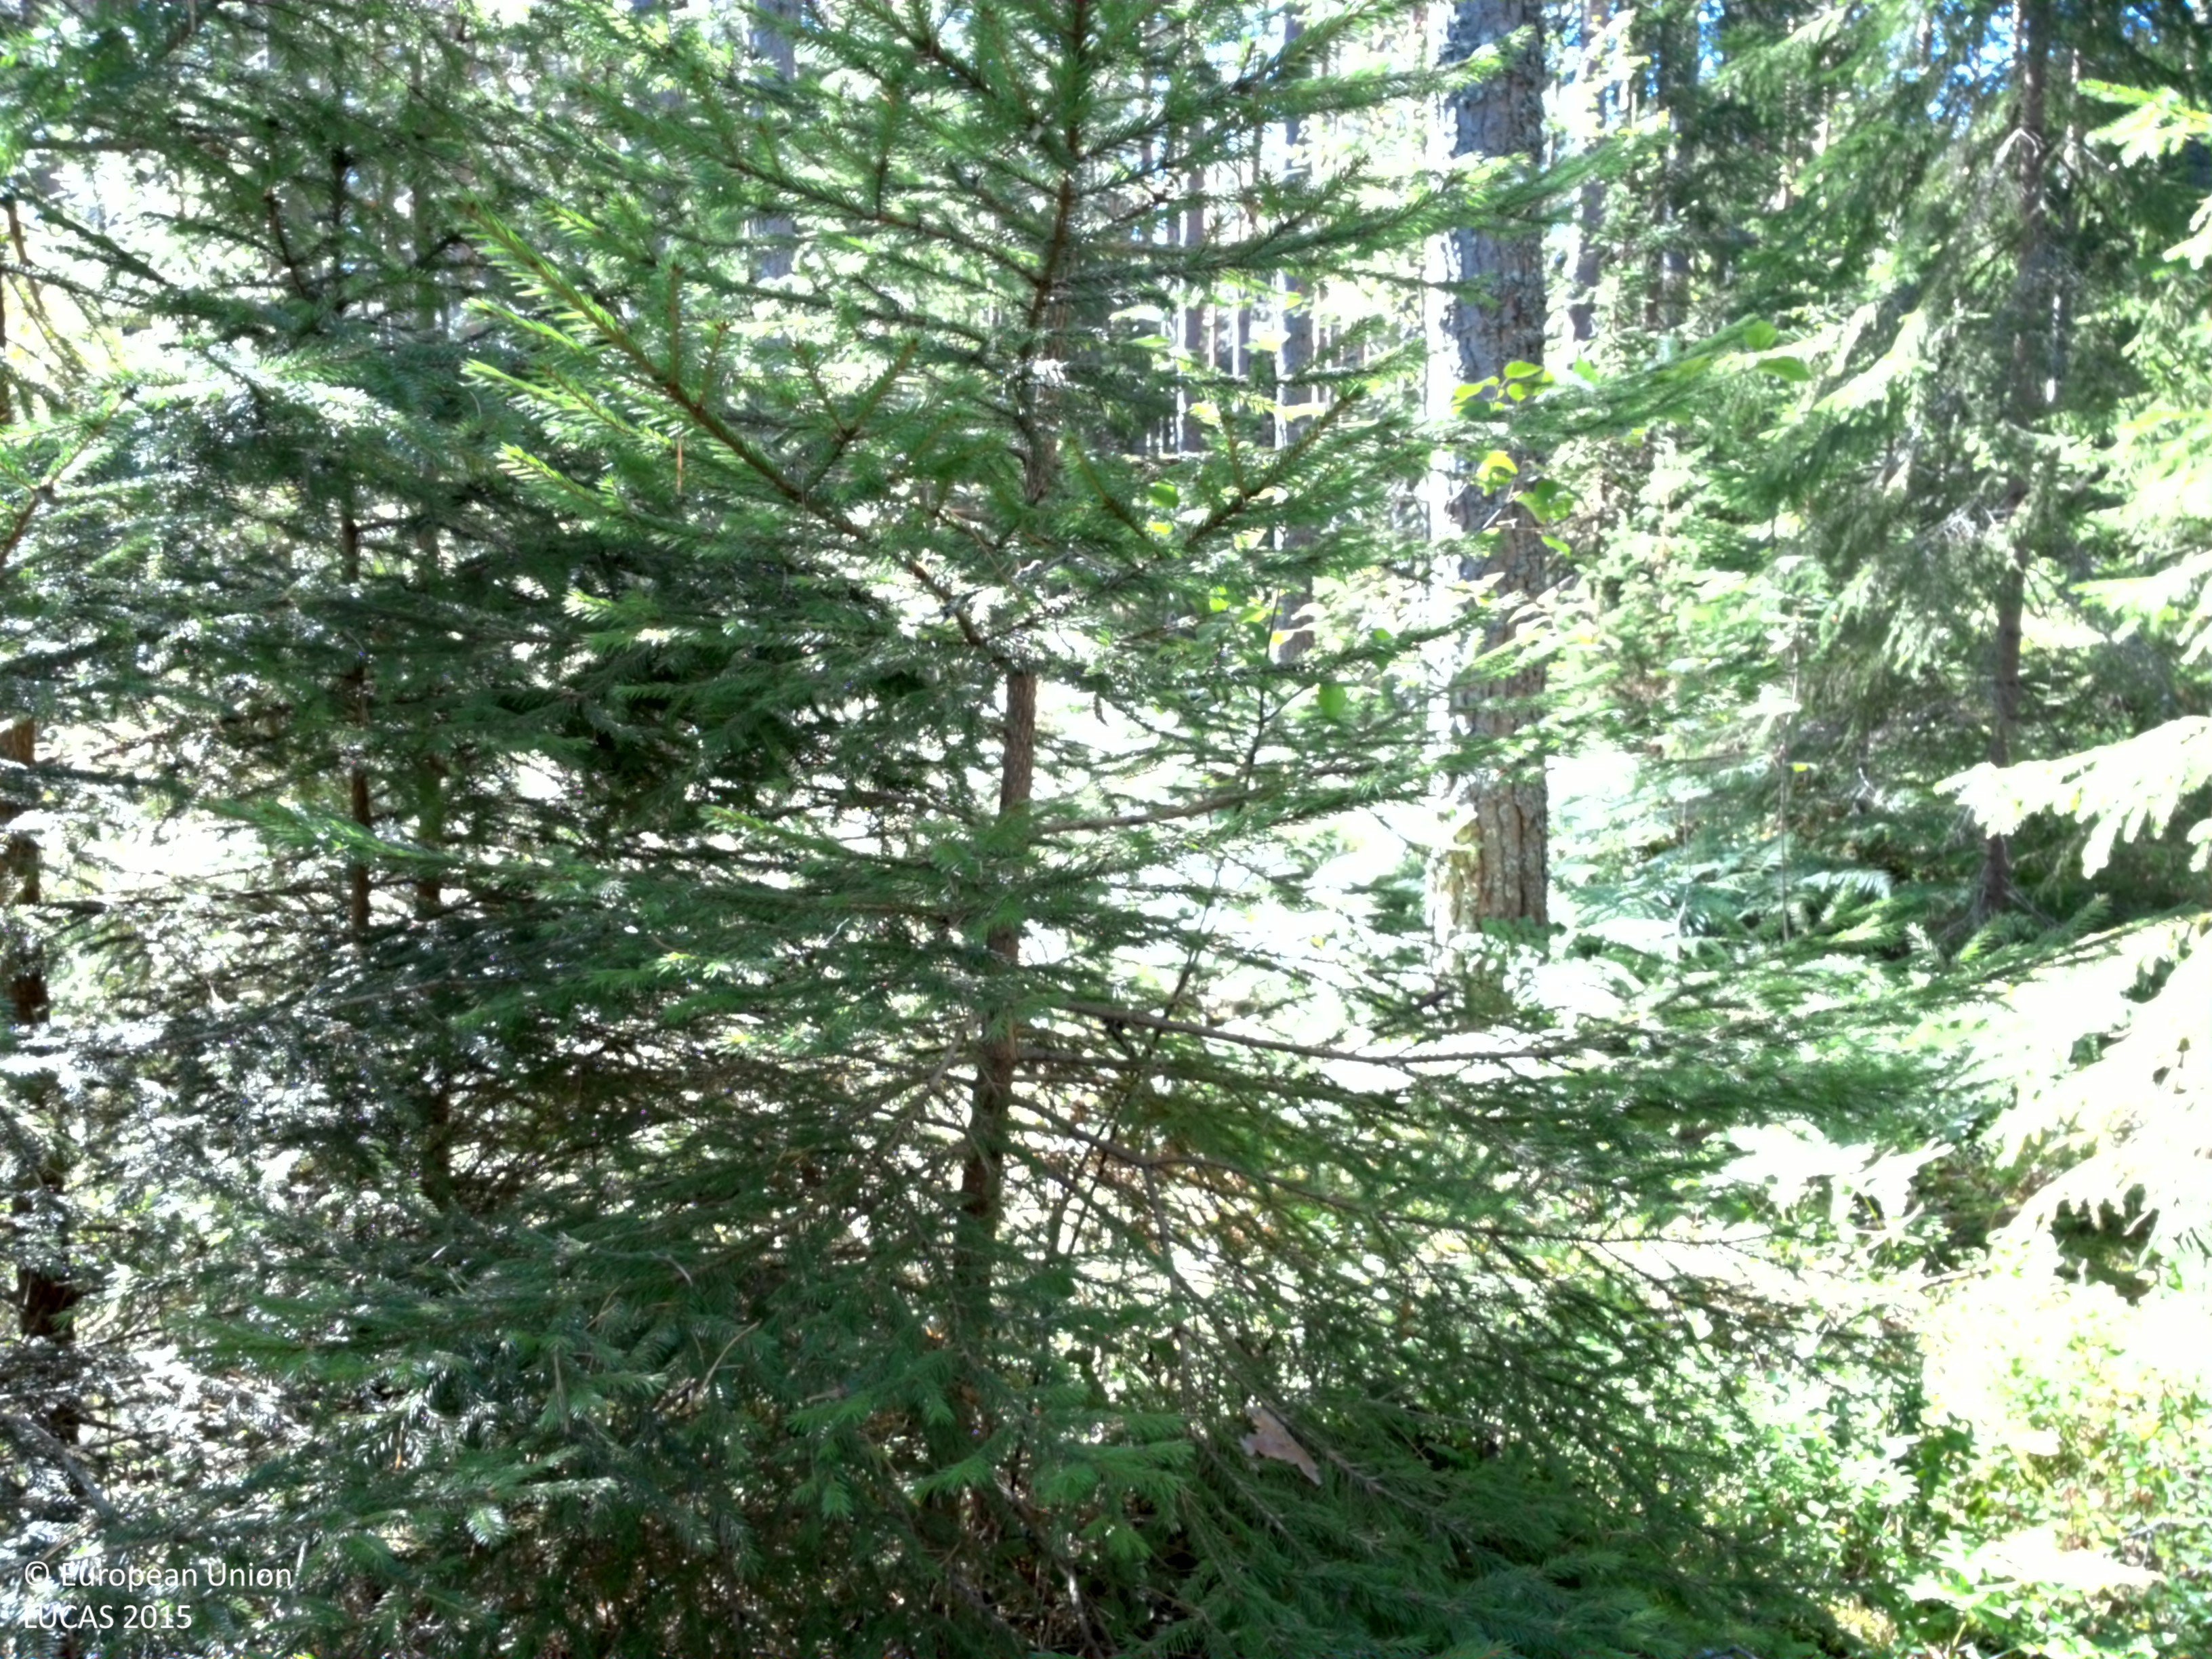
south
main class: Woodland
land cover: Other coniferous woodland
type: boreal forest
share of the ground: > 75 %
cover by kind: coniferous forest trees 75 %, shrubs 15 %, broadleaved forest trees 5 %, herbaceous plants 5 %
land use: Forestry
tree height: > 5 m
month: August
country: SE
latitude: 60.0782
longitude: 17.0187
